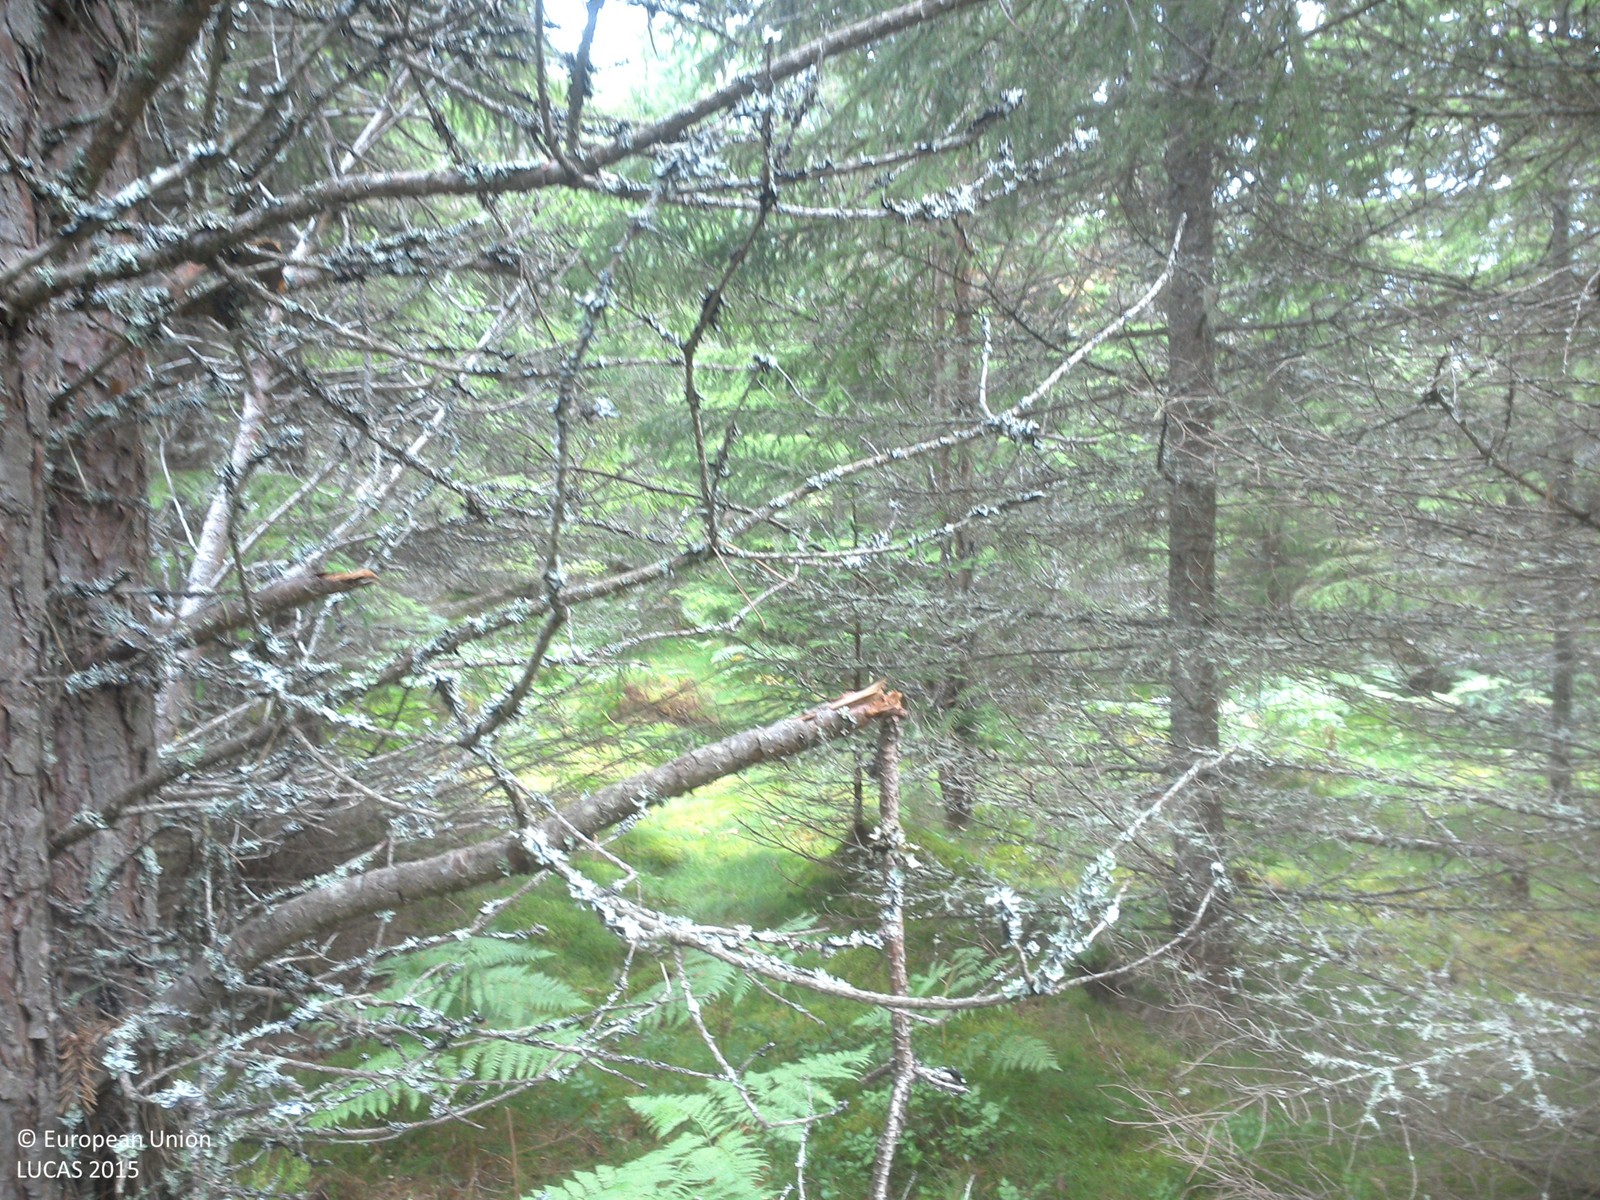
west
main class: Woodland
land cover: Spruce dominated coniferous woodland
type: boreal forest
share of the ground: > 75 %
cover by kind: coniferous forest trees 80 %, shrubs 10 %, lichens and mosses 10 %
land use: Forestry
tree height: > 5 m
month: August
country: SE
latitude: 57.7661
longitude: 15.4592
